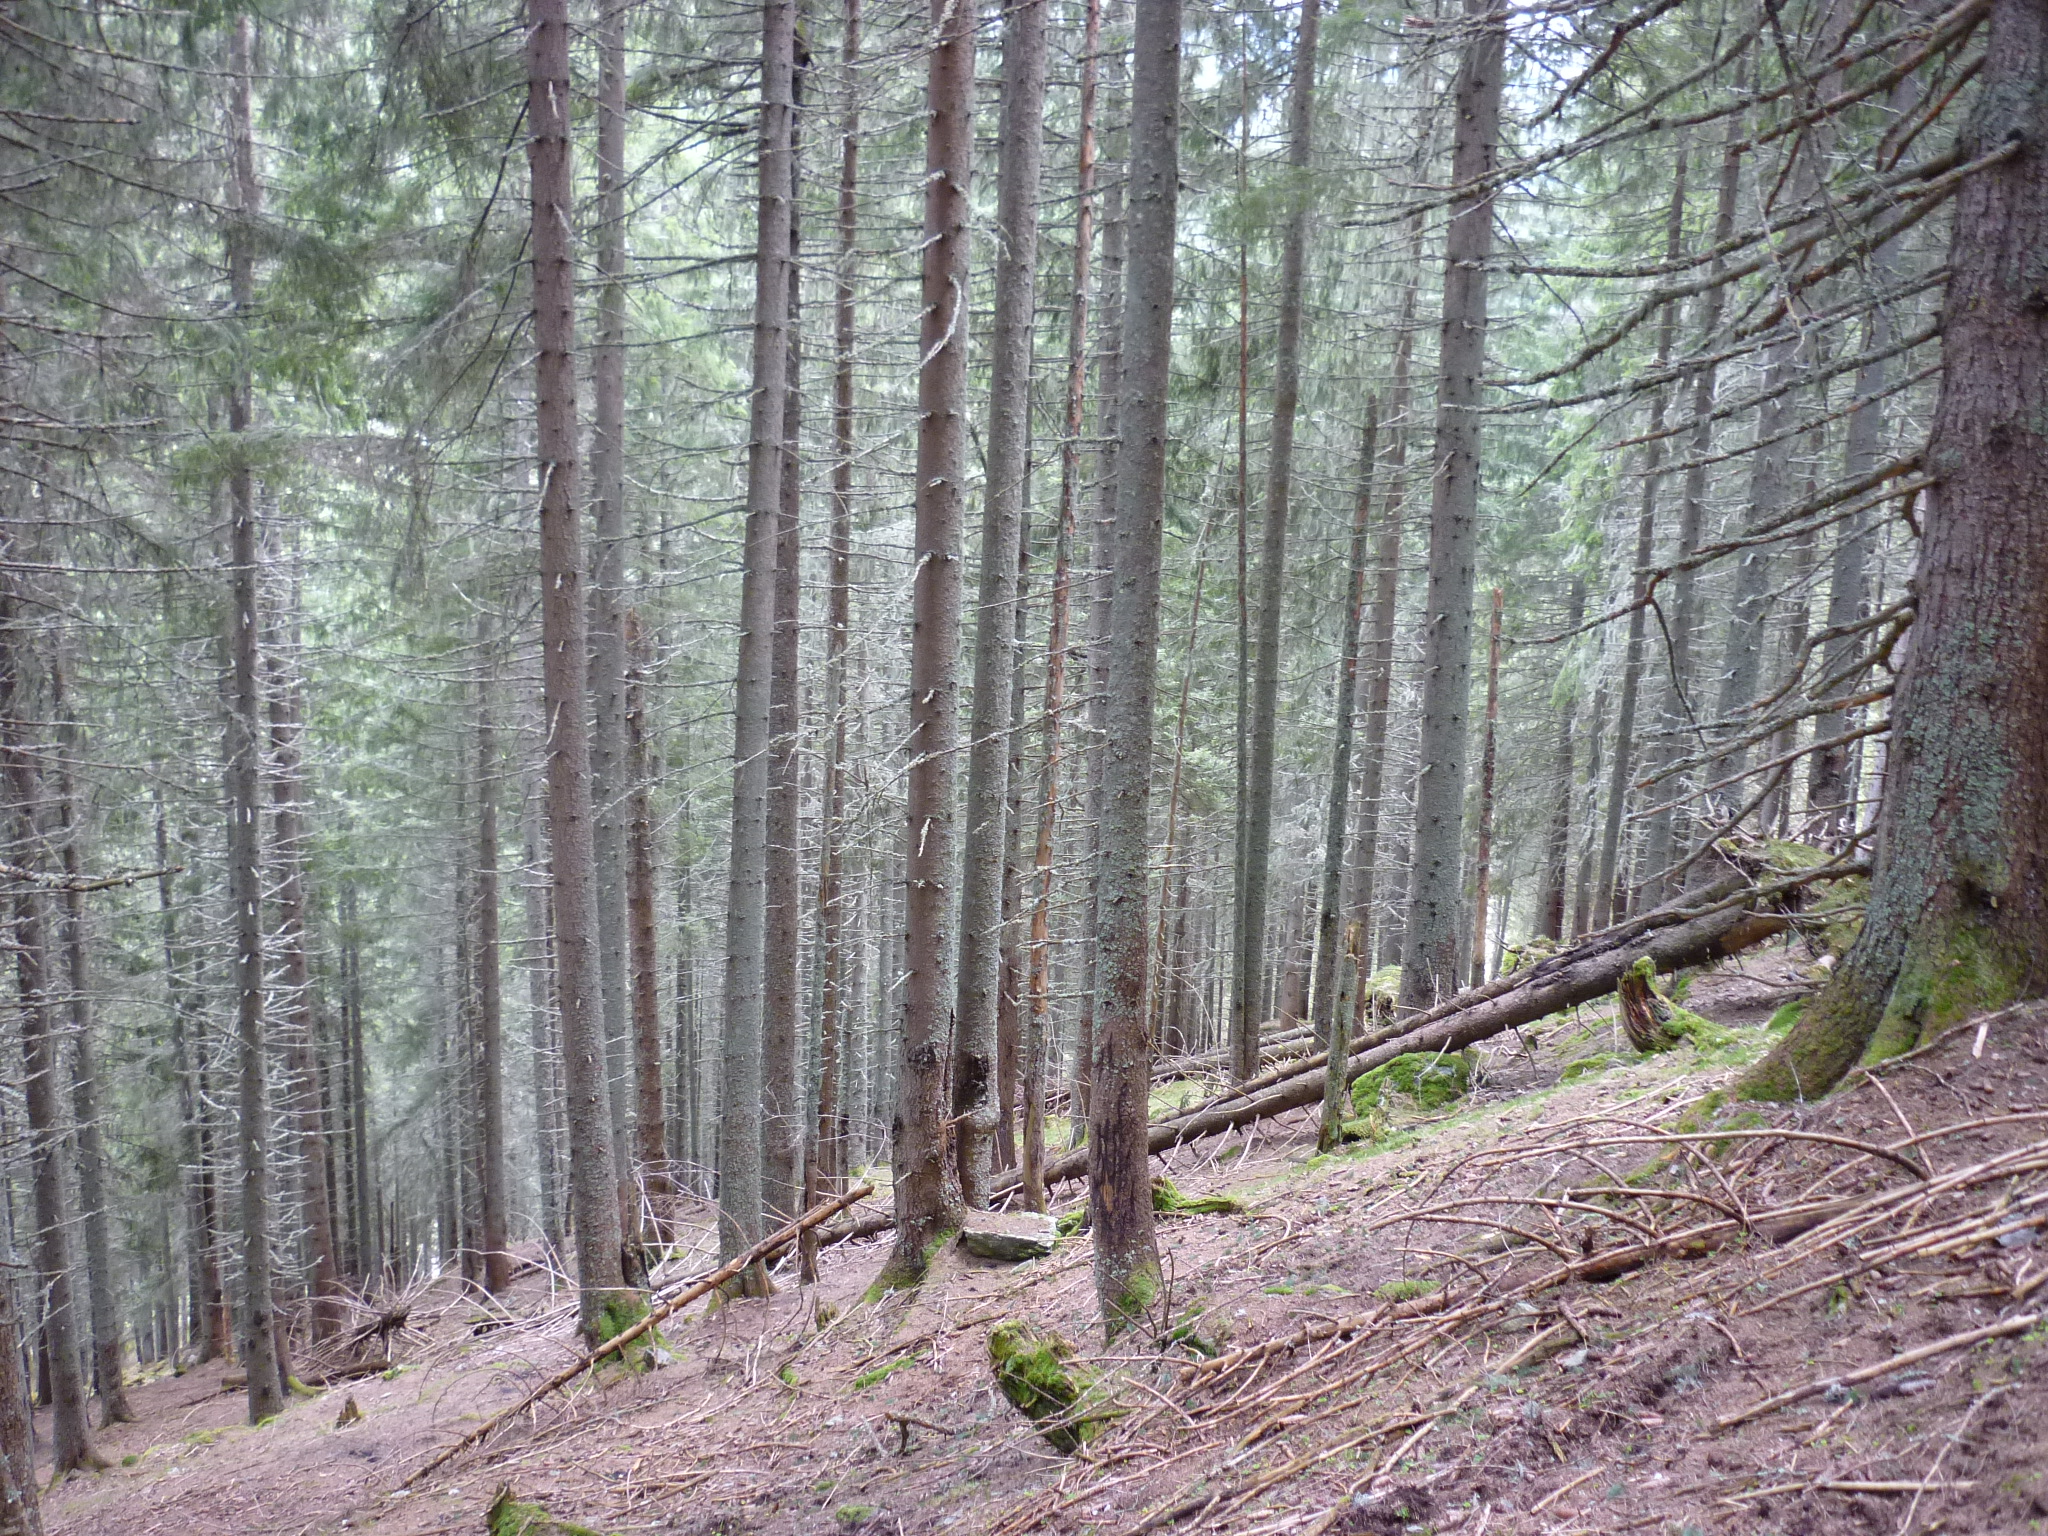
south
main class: Woodland
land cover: Spruce dominated coniferous woodland
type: alpine coniferous forest
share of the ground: > 75 %
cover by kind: coniferous forest trees 90 %, lichens and mosses 5 %, unconsolidated bare surface 5 %
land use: Forestry
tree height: > 5 m
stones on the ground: < 10 %
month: May
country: AT
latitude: 47.4196
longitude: 14.2802
